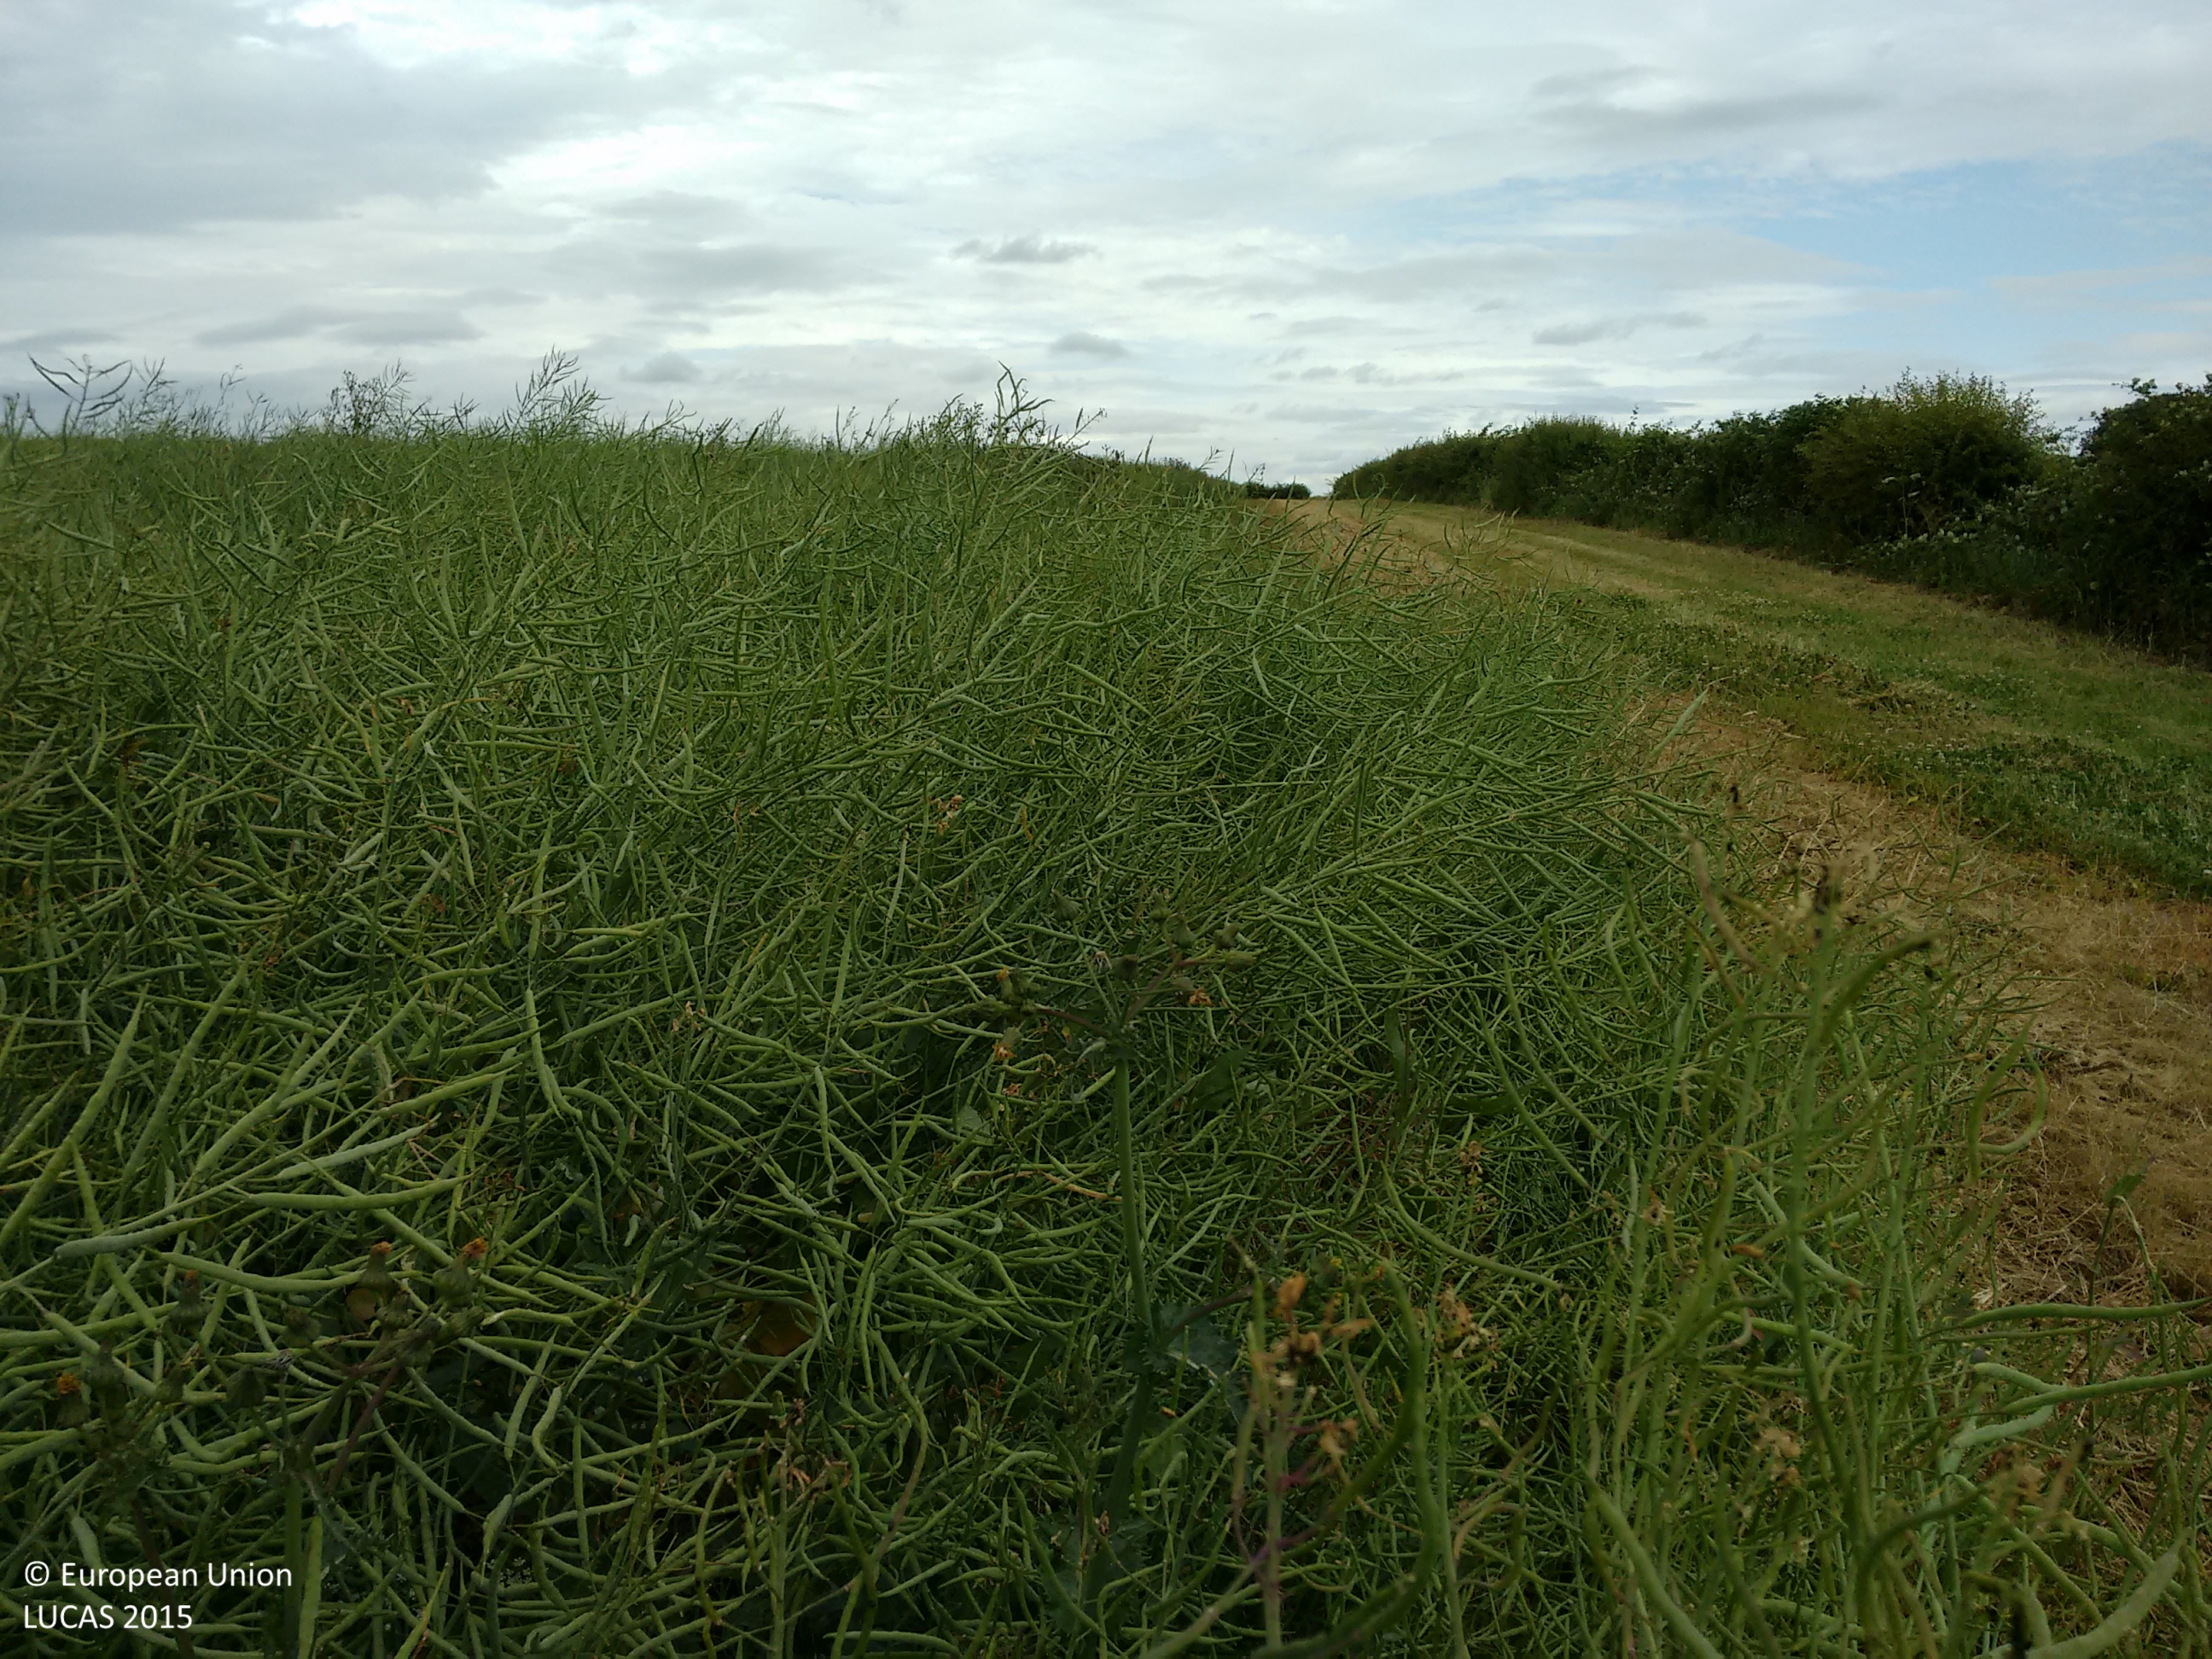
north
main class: Cropland
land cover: Rape and turnip rape
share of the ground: > 75 %
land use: Agriculture (excluding fallow land and kitchen gardens)
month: July
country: GB
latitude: 51.8082
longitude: -1.5828
